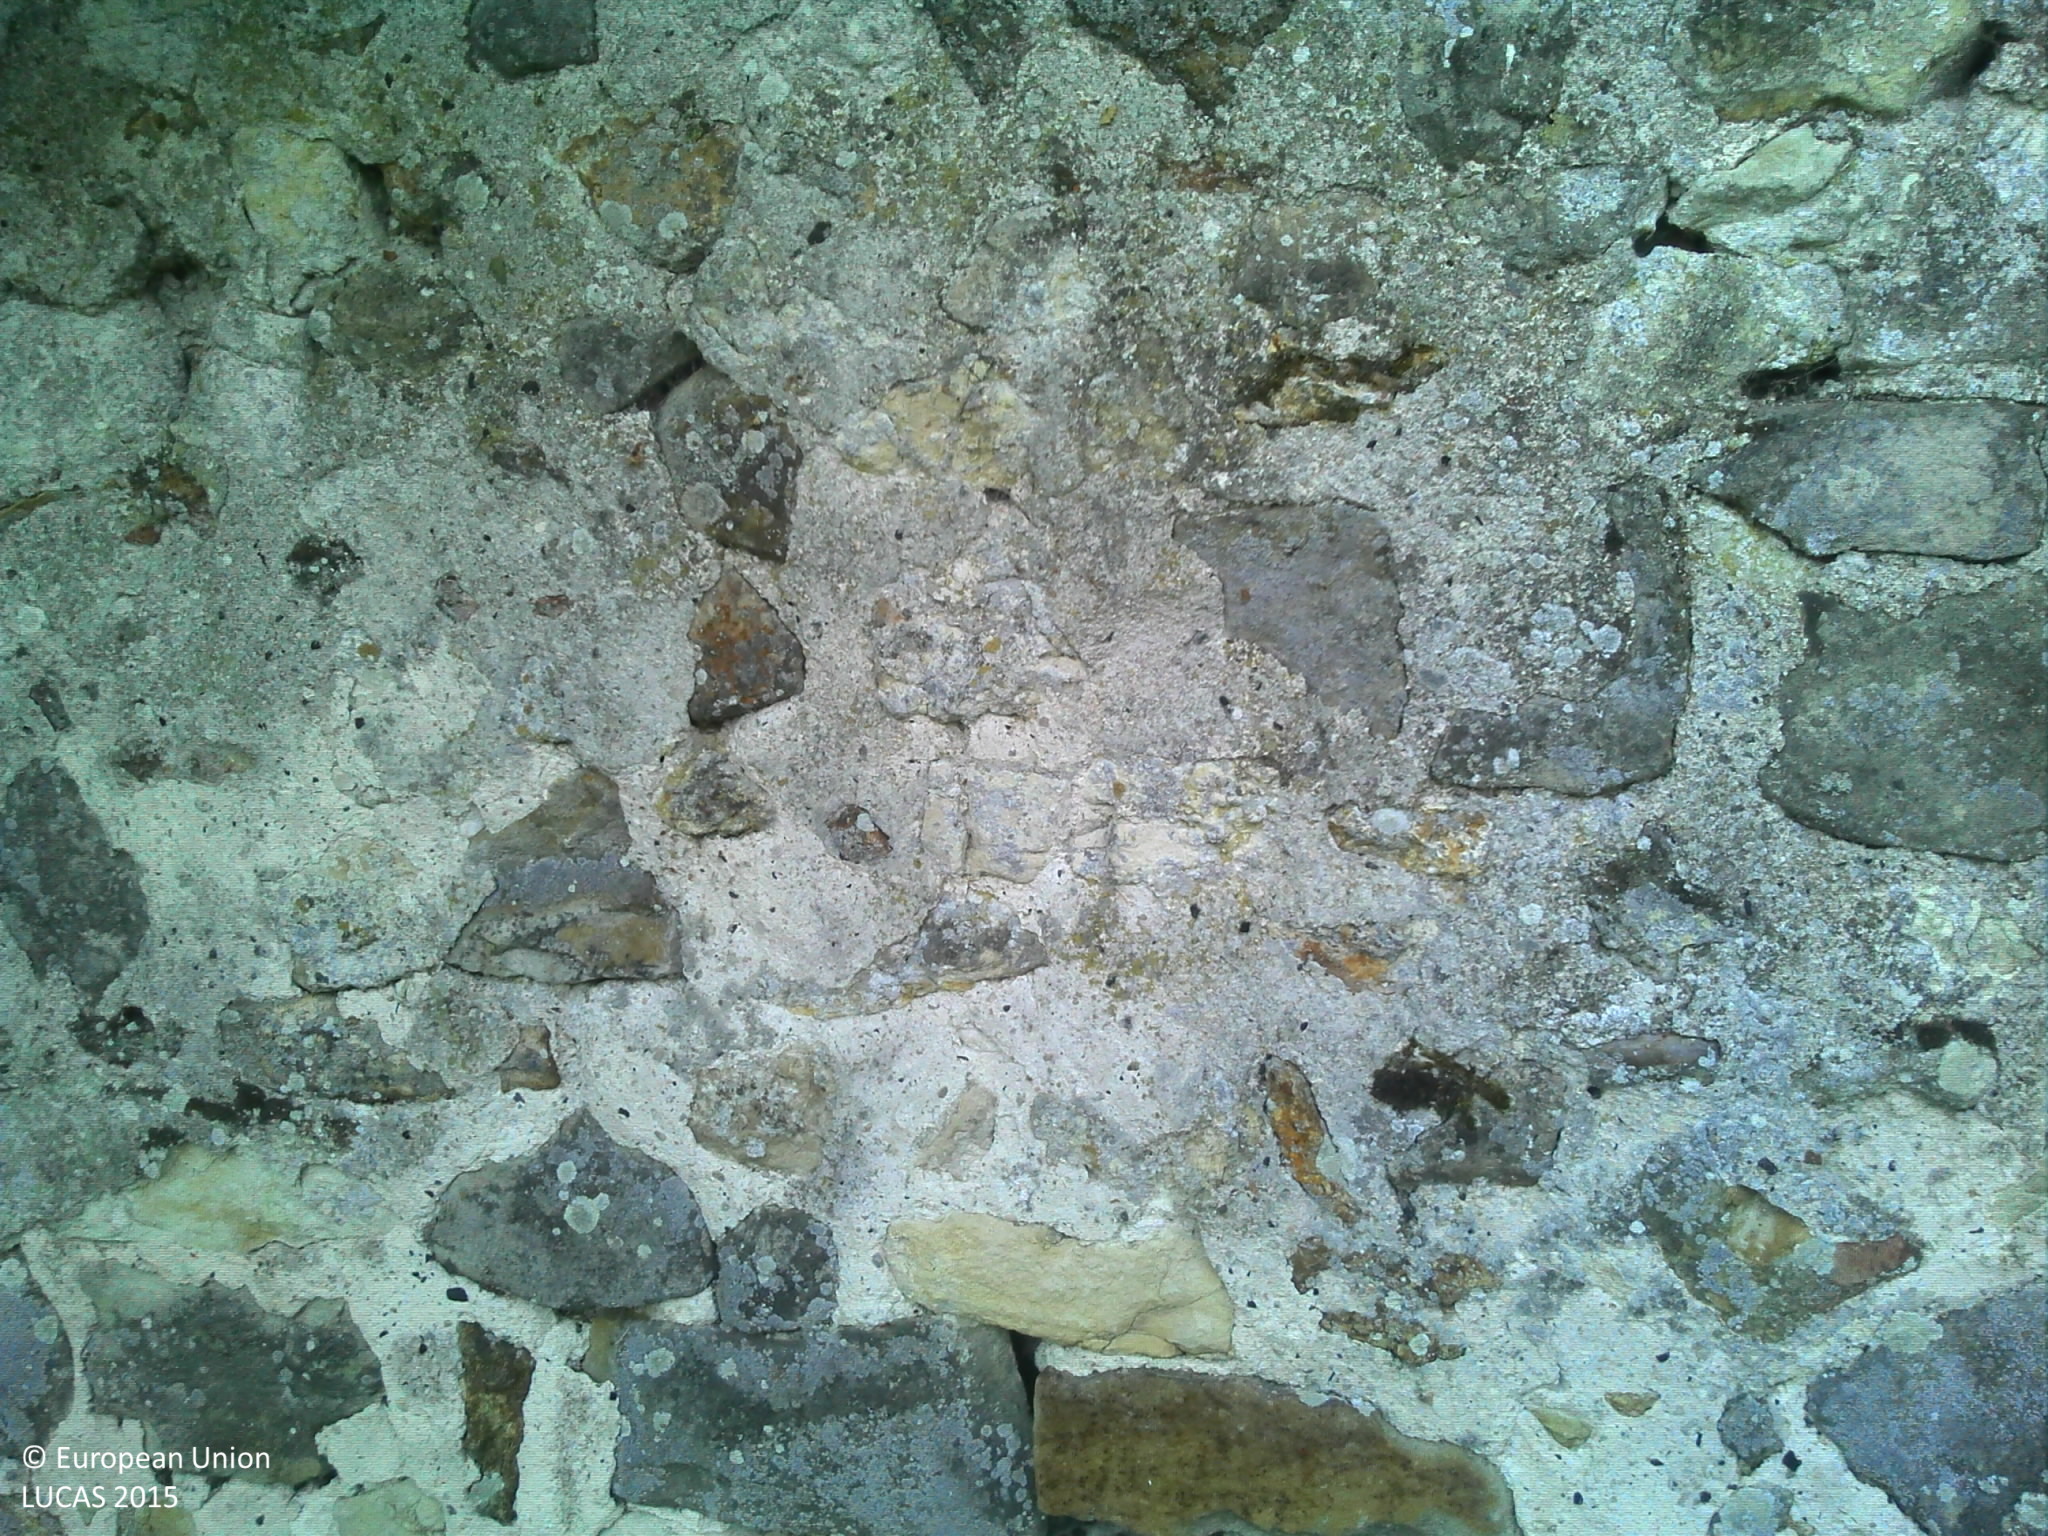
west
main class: Cropland
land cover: Rape and turnip rape
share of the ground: > 75 %
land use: Agriculture (excluding fallow land and kitchen gardens)
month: July
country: FR
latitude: 49.1220
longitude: 3.3193
